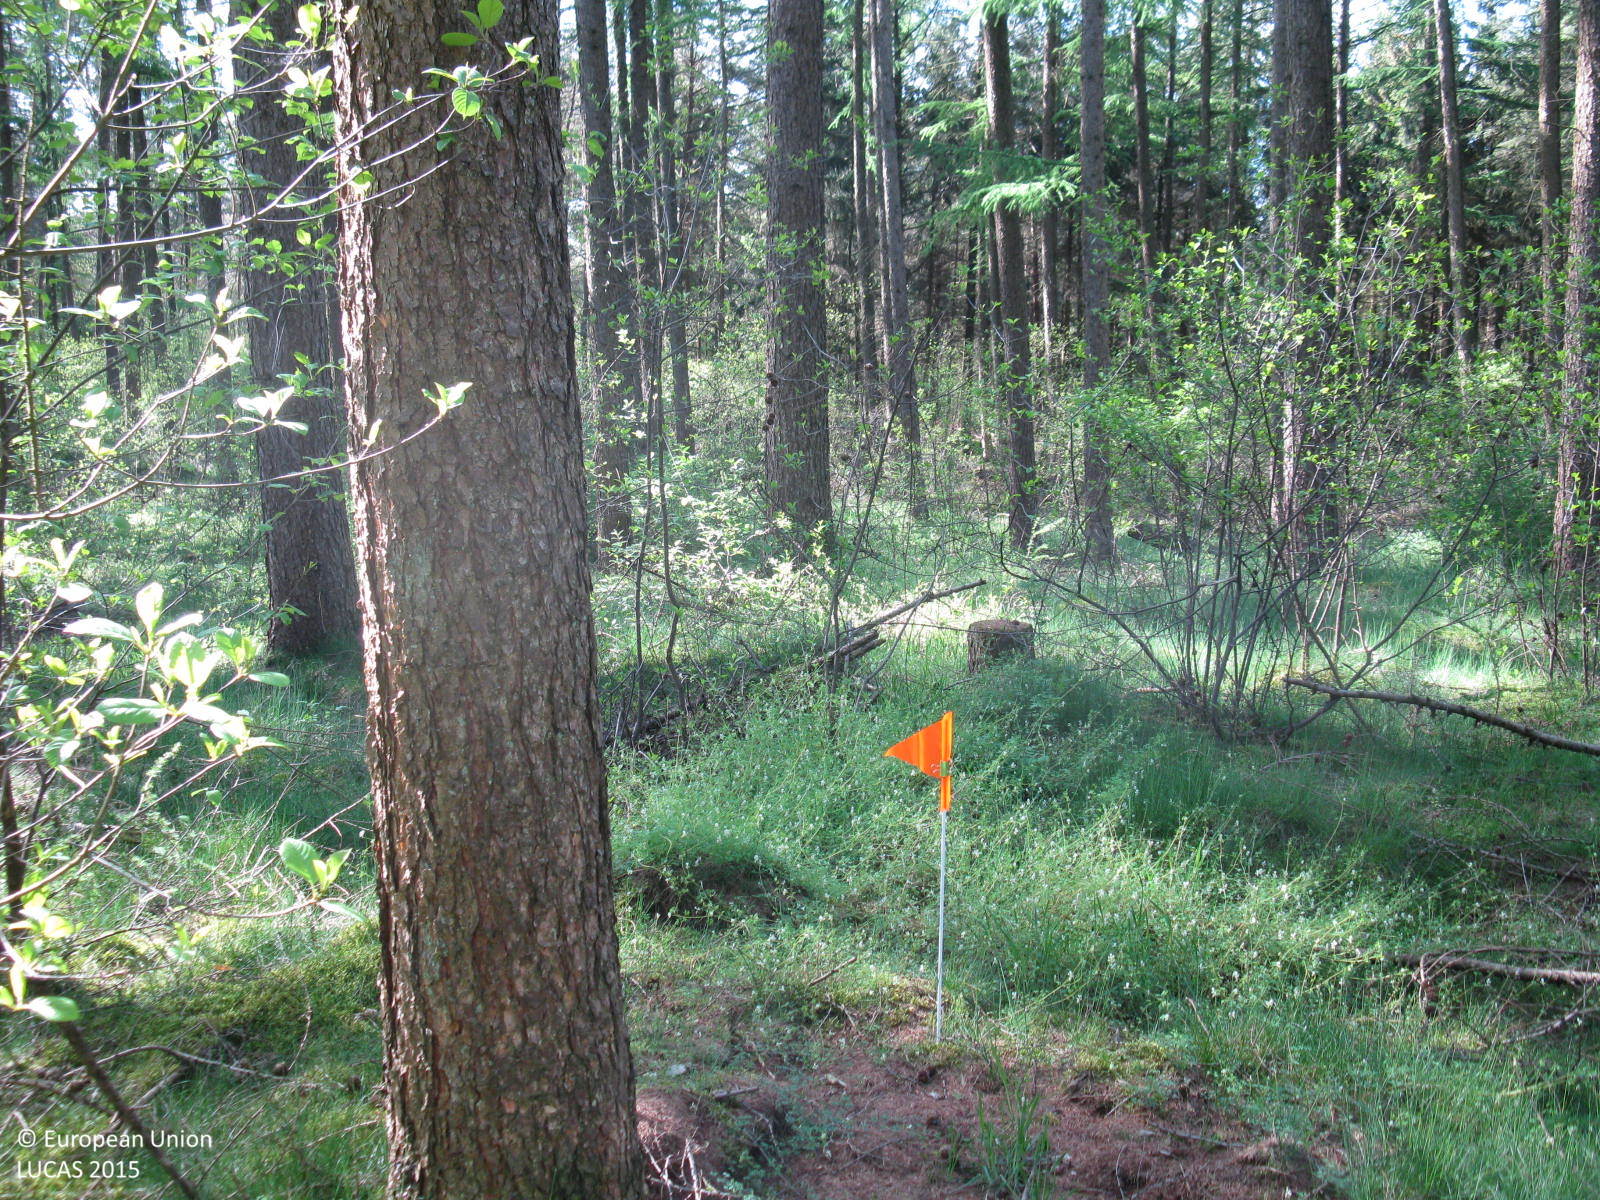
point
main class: Woodland
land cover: Other coniferous woodland
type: hemiboreal forest and nemoral coniferous forest and mixed broadleaved-coniferous forest
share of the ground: > 75 %
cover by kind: coniferous forest trees 100 %
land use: Forestry
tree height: > 5 m
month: May
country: DE
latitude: 52.8147
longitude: 7.3149
